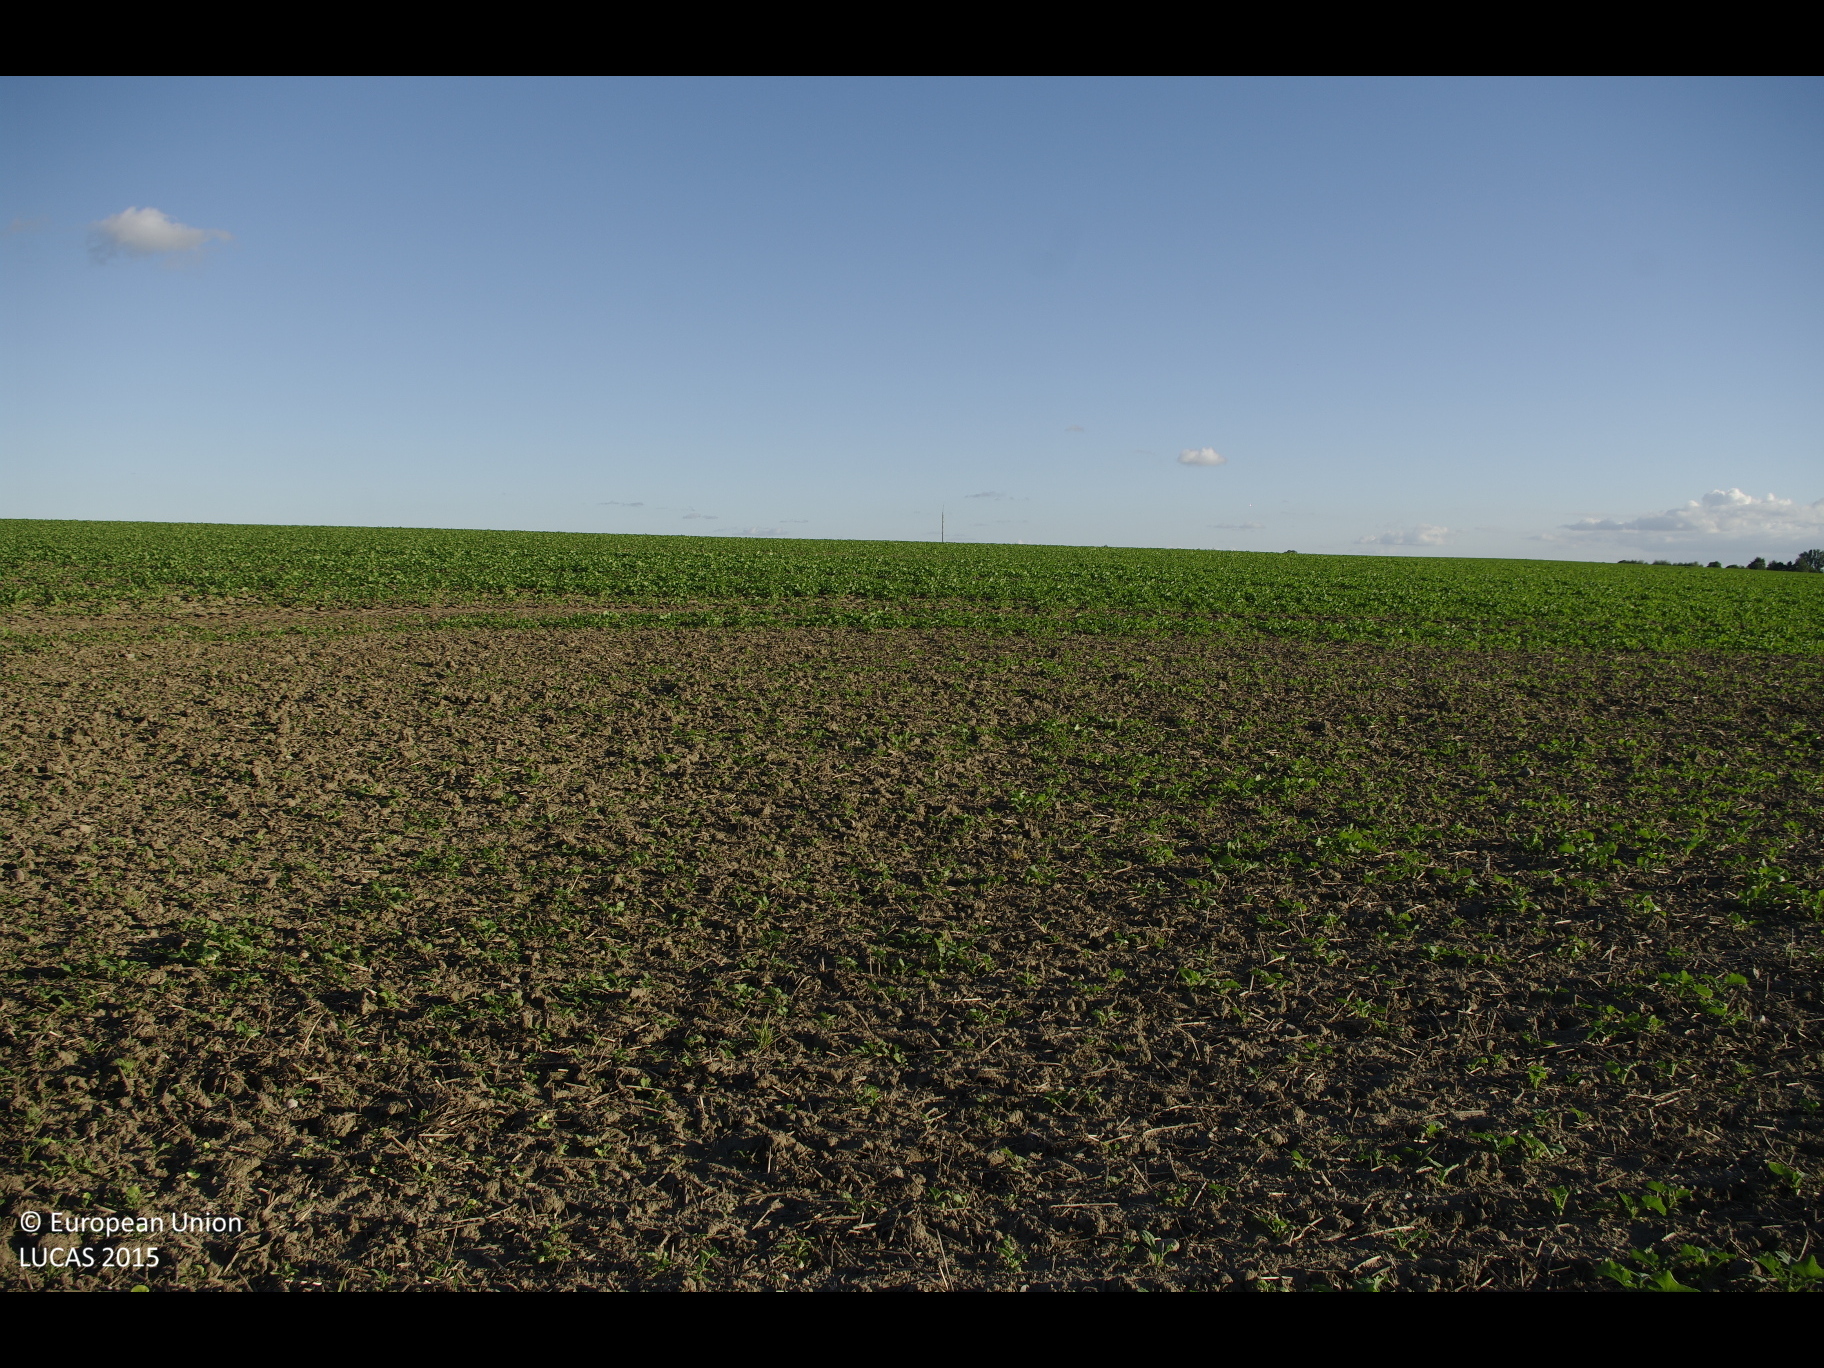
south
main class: Cropland
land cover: Rape and turnip rape
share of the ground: 50 - 75 %
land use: Agriculture (excluding fallow land and kitchen gardens)
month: September
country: DE
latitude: 53.9191
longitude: 10.9892
